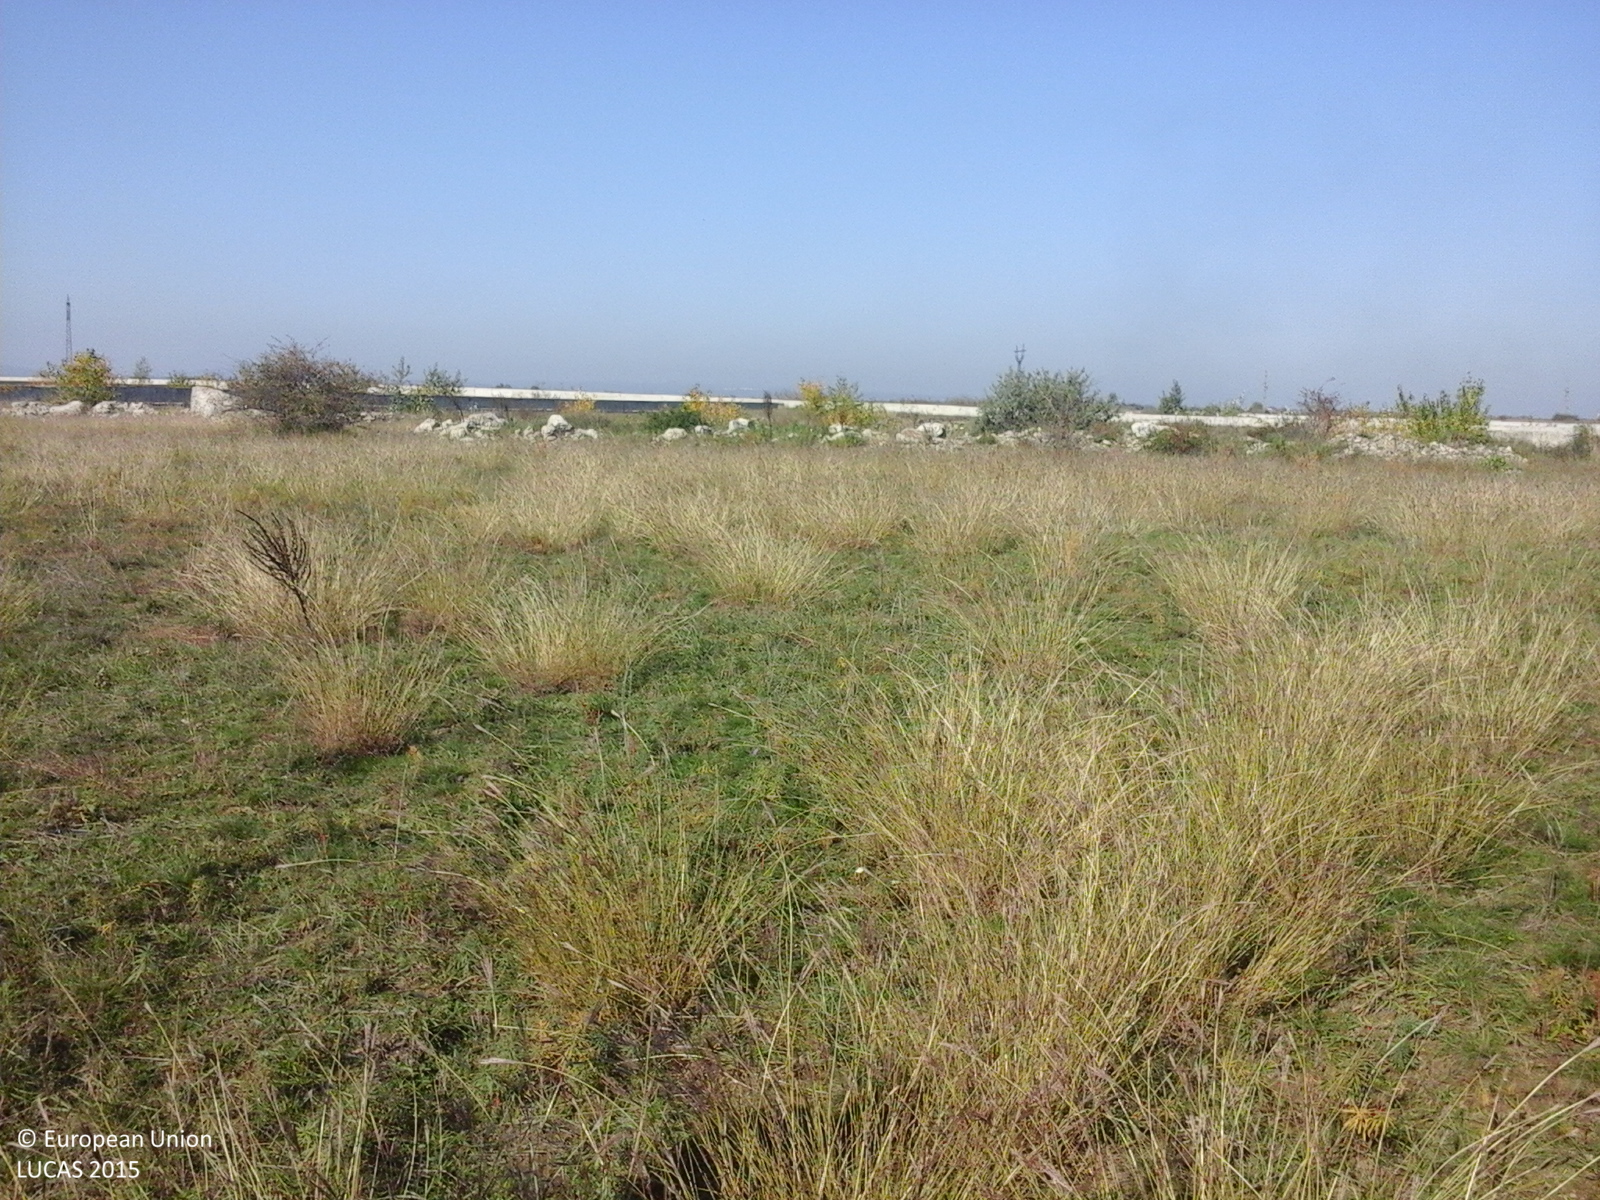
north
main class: Grassland
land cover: Grassland without tree/shrub cover
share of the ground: > 75 %
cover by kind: herbaceous plants 100 %
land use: Agriculture (excluding fallow land and kitchen gardens)
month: October
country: RO
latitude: 45.7920
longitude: 27.1925
